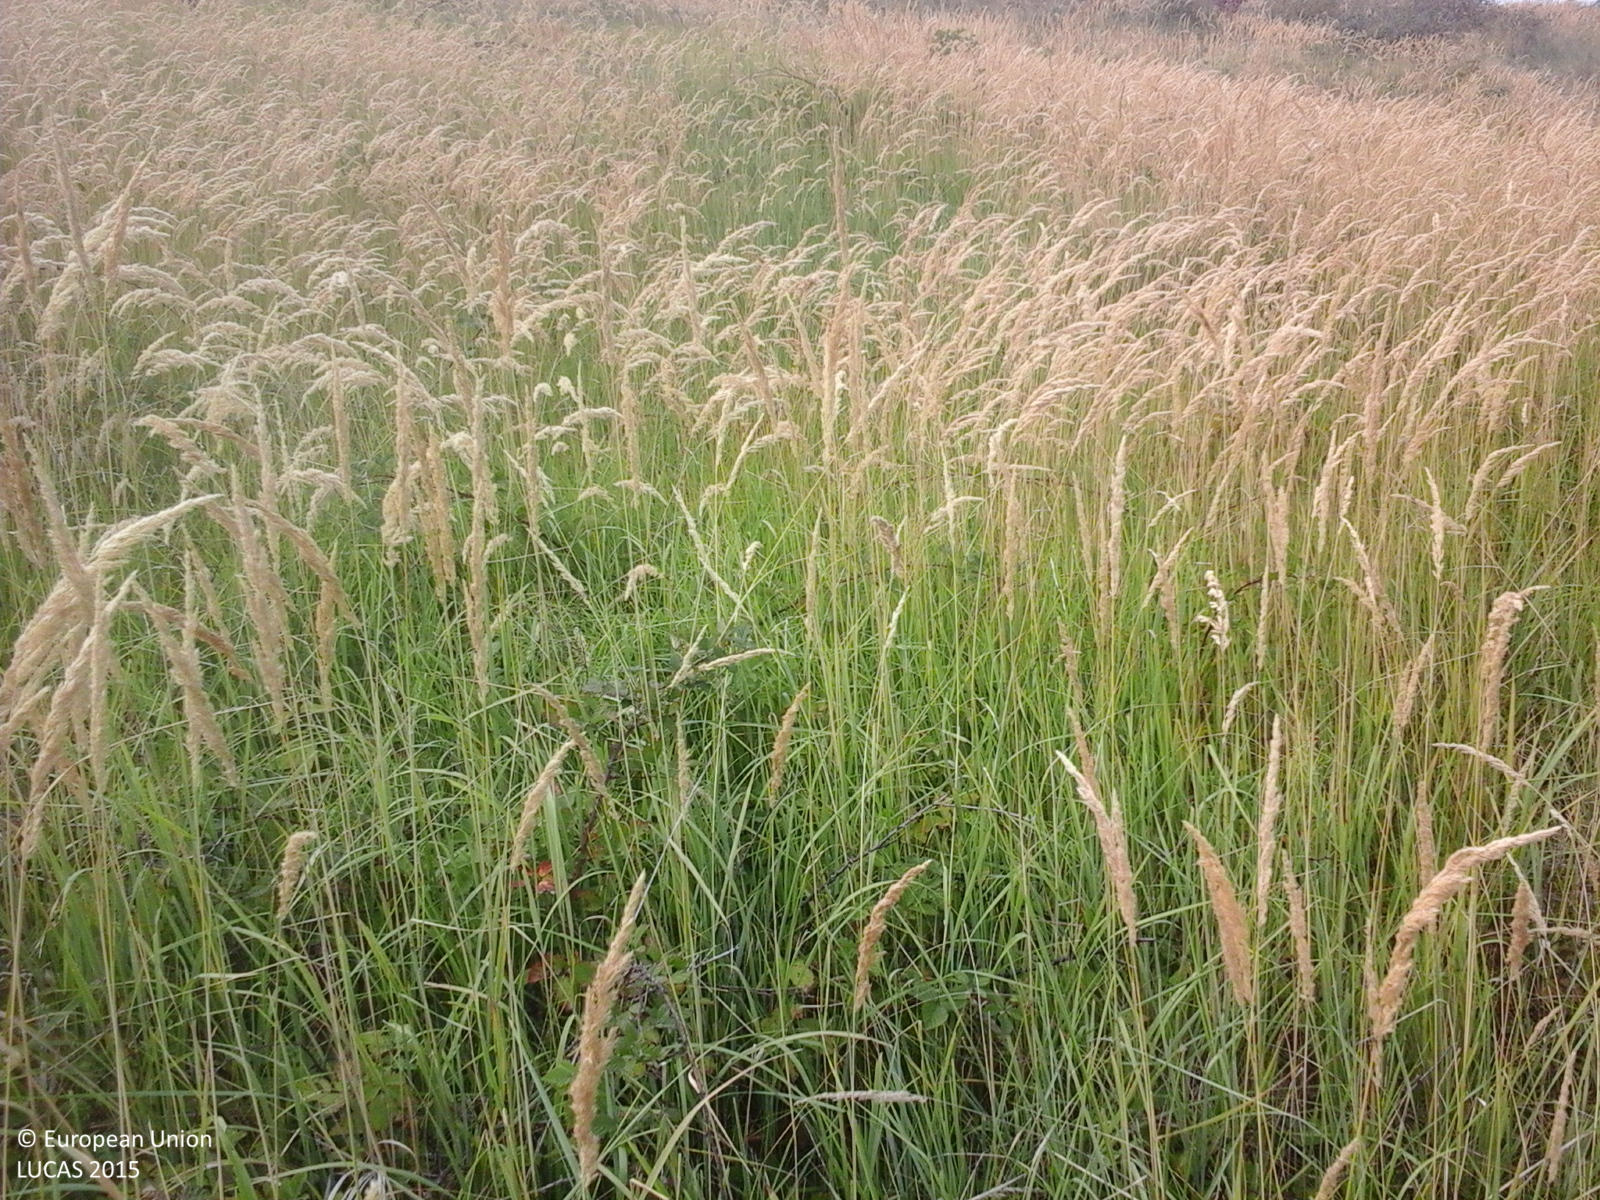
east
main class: Grassland
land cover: Grassland with sparse tree/shrub cover
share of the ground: > 75 %
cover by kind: herbaceous plants 85 %, shrubs 10 %, broadleaved forest trees 5 %
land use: Fallow land
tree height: < 5 m
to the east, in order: Grassland with sparse tree/shrub cover; Tracks; Shrubland with sparse tree cover; Grassland with sparse tree/shrub cover
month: September
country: RO
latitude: 45.7377
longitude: 22.8395
